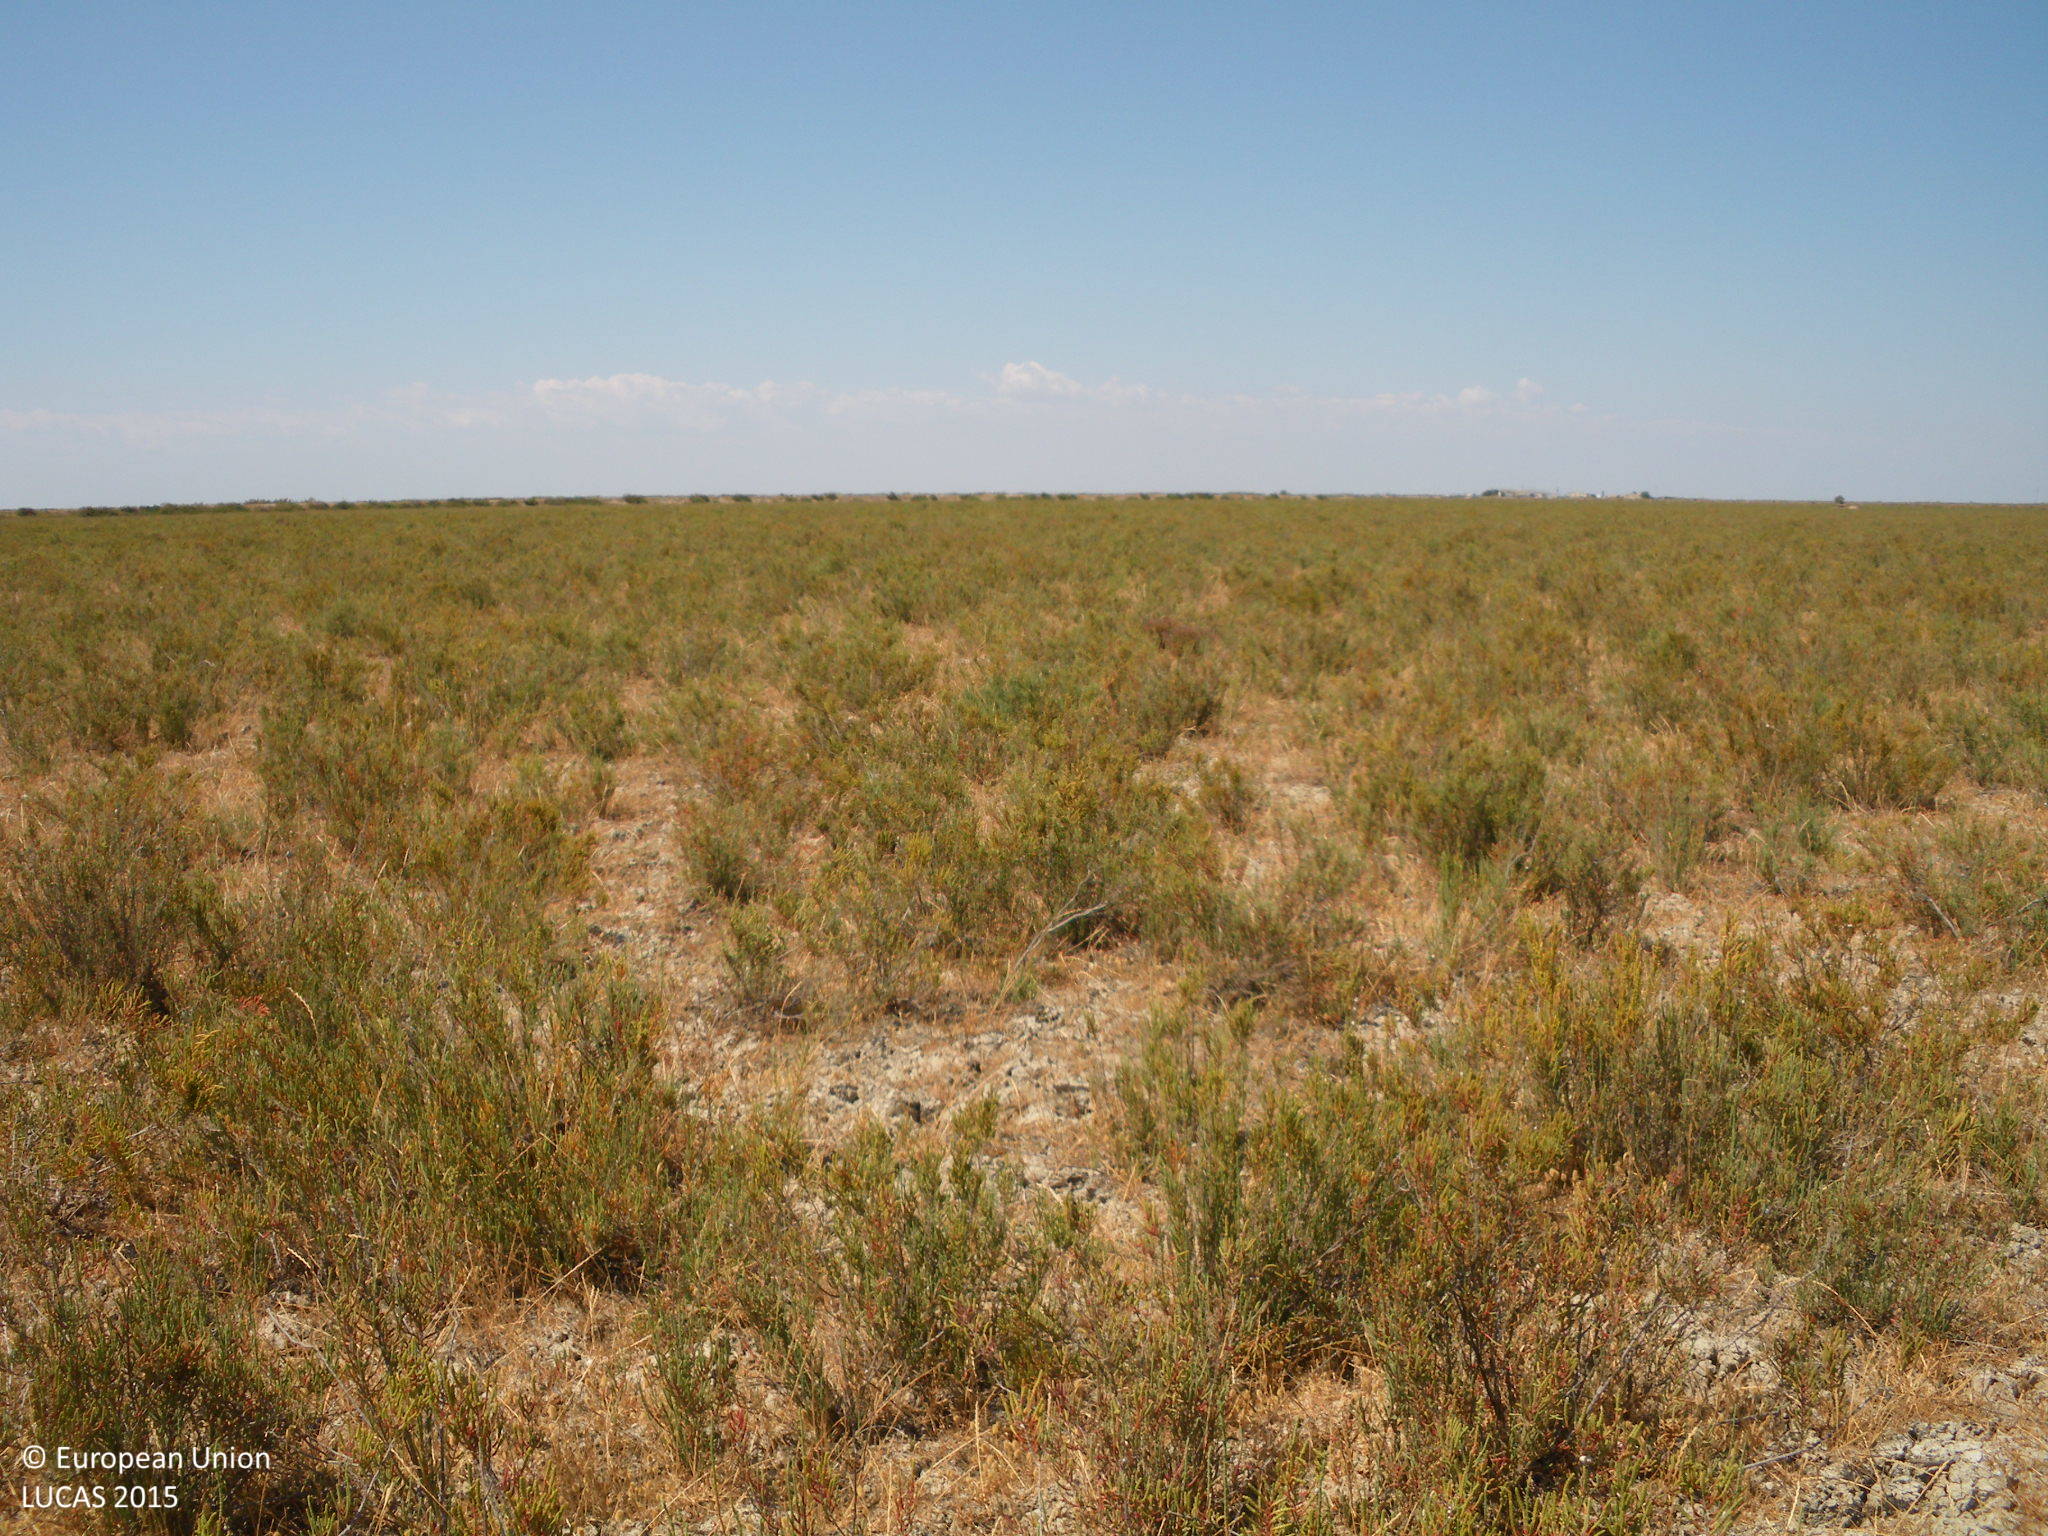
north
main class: Shrubland
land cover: Shrubland without tree cover
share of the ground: 50 - 75 %
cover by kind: shrubs 50 %, herbaceous plants 35 %, unconsolidated bare surface 15 %
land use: Agriculture (excluding fallow land and kitchen gardens)
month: May
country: ES
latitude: 36.8846
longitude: -6.2993
